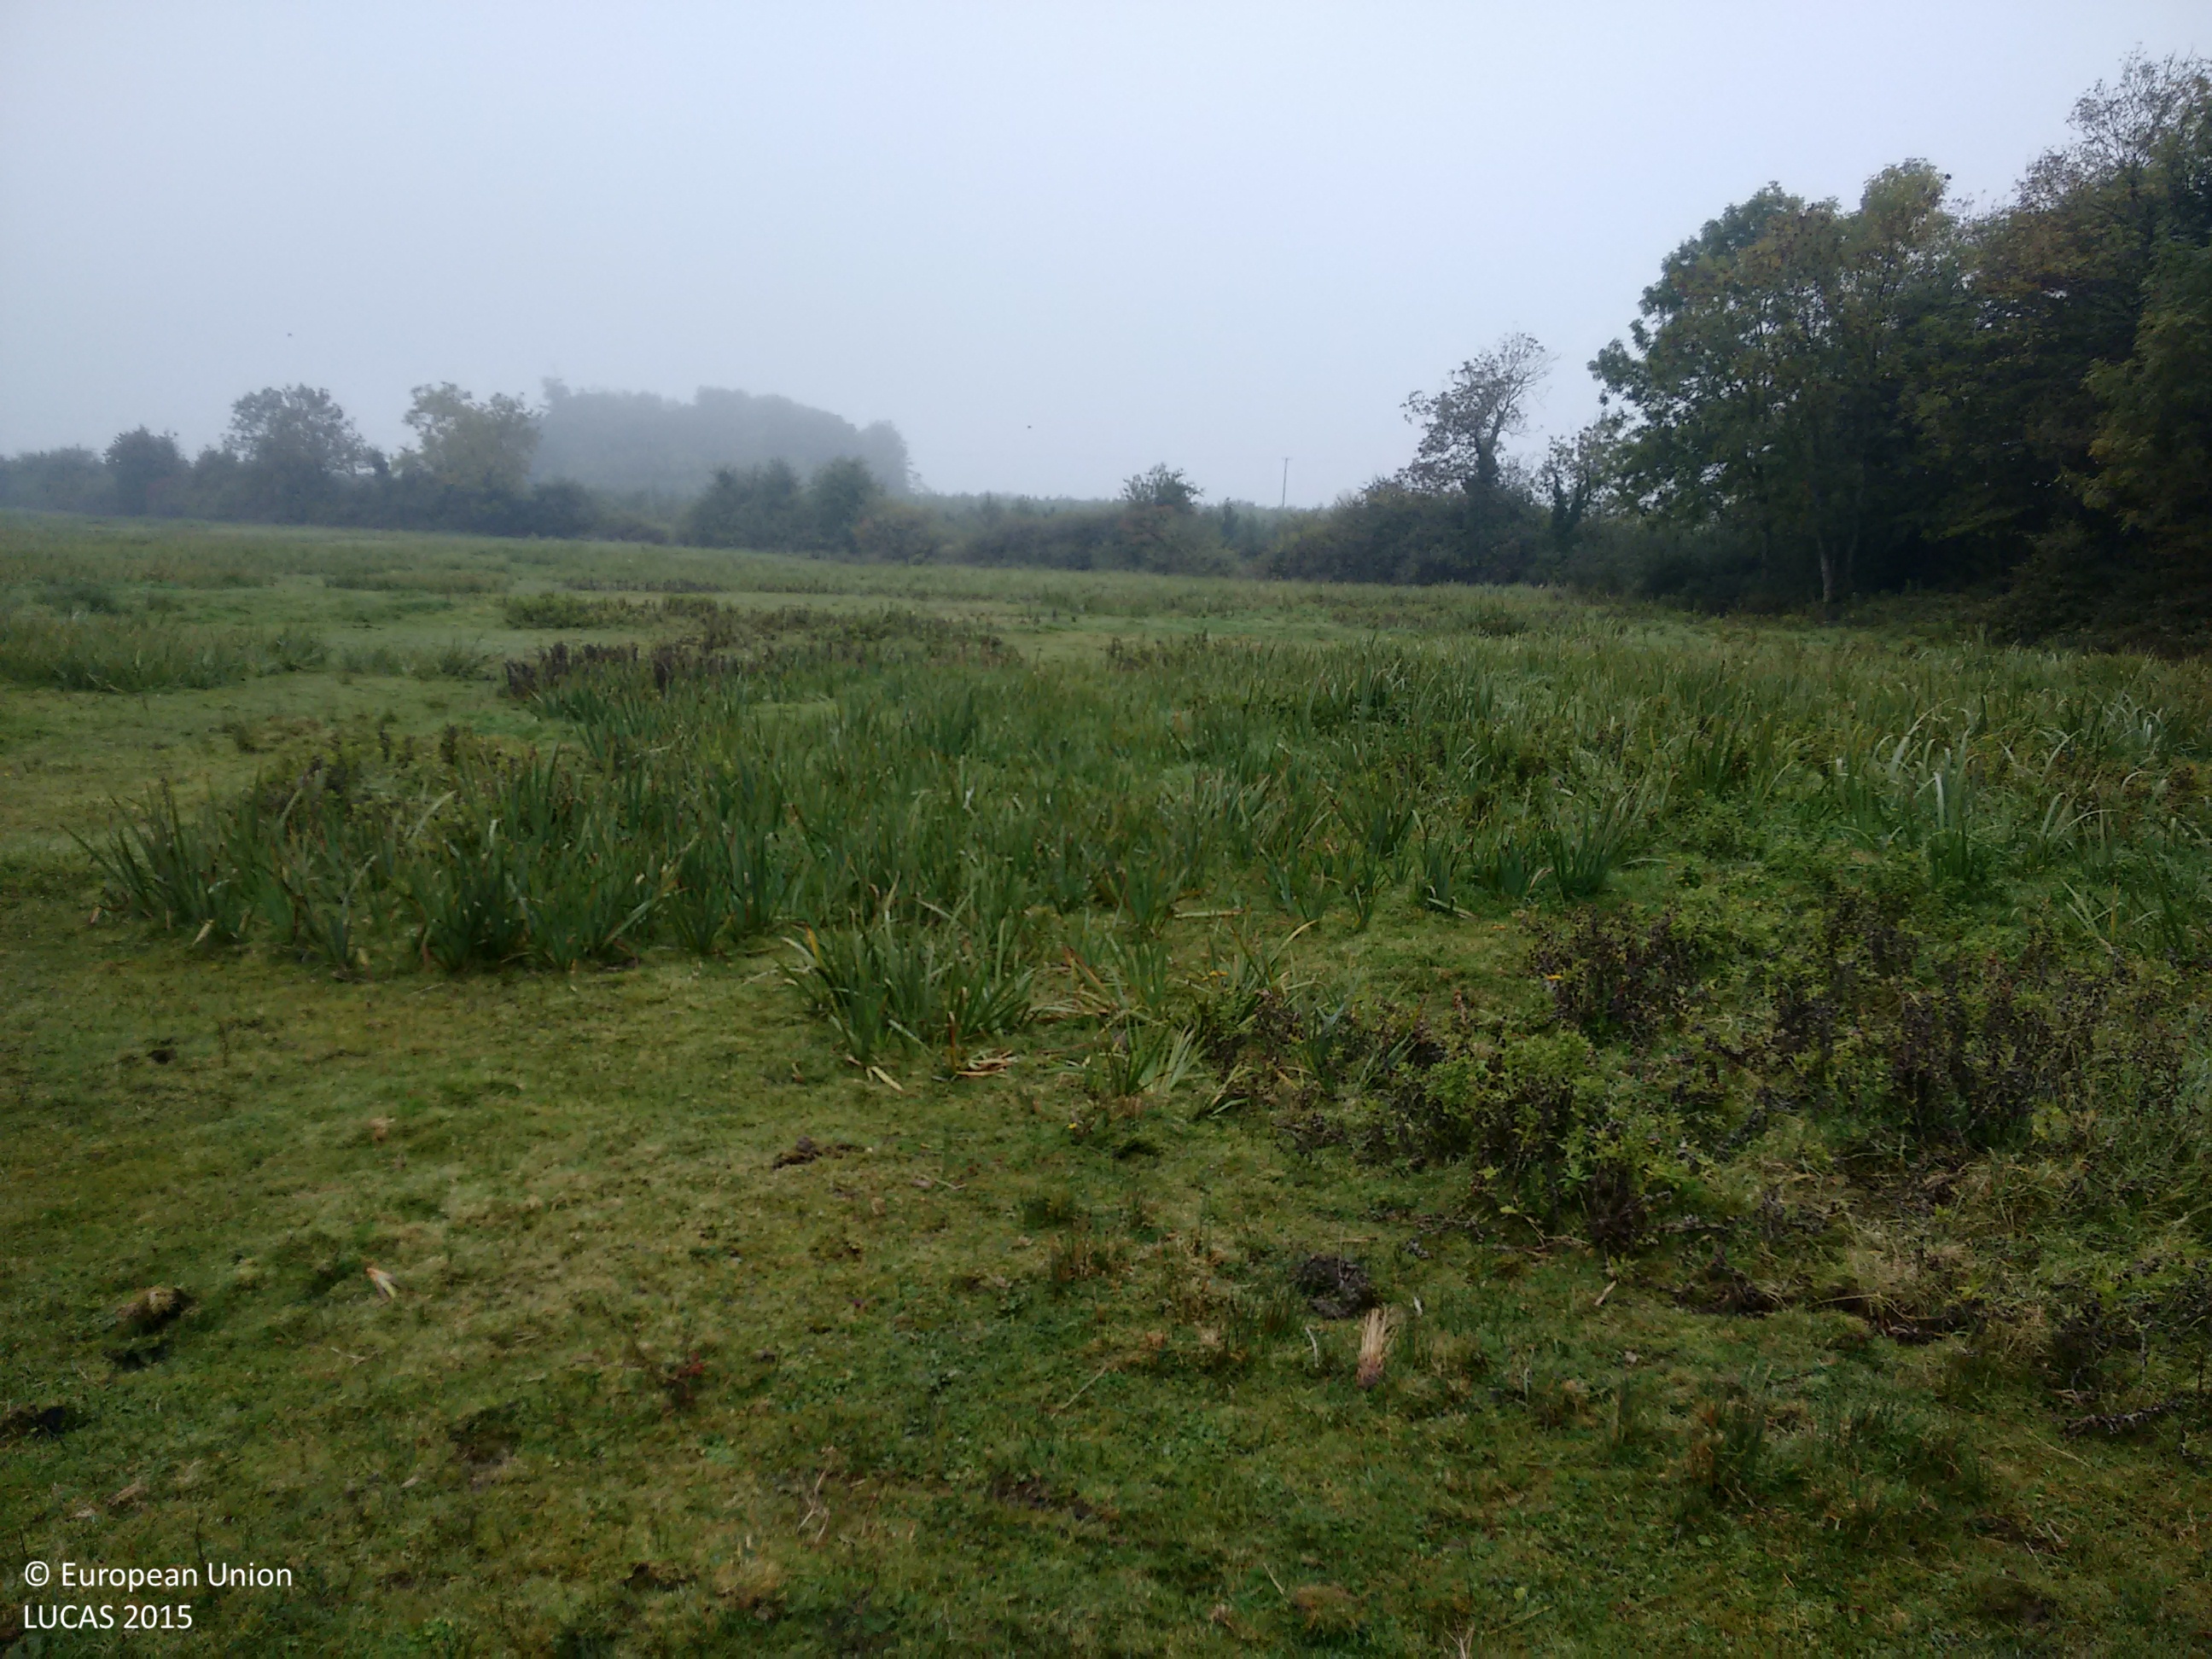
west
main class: Grassland
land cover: Grassland without tree/shrub cover
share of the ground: > 75 %
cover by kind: herbaceous plants 75 %, shrubs 5 %
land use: Agriculture (excluding fallow land and kitchen gardens)
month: October
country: IE
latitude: 52.4541
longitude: -8.9742
